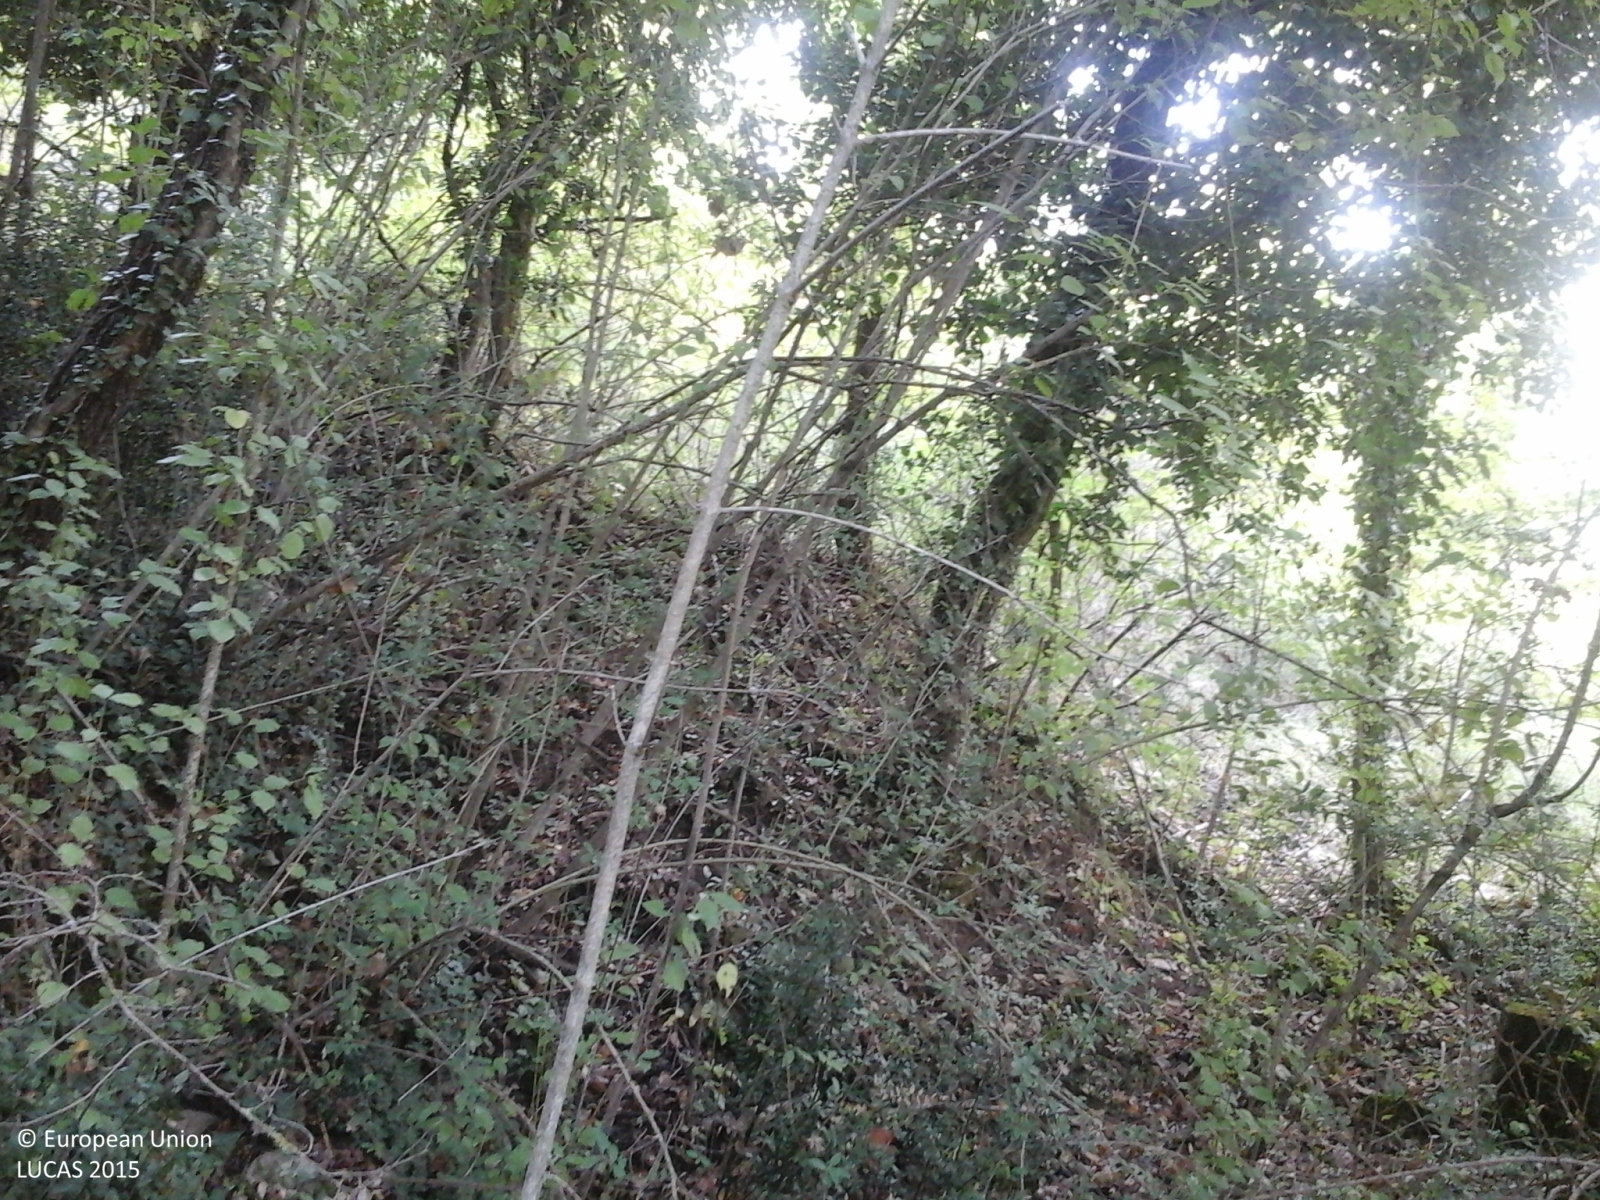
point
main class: Woodland
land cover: Broadleaved woodland
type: thermophilous deciduous forest
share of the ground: > 75 %
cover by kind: broadleaved forest trees 70 %, shrubs 30 %
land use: Forestry
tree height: > 5 m
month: October
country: IT
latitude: 43.4247
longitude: 12.2050
